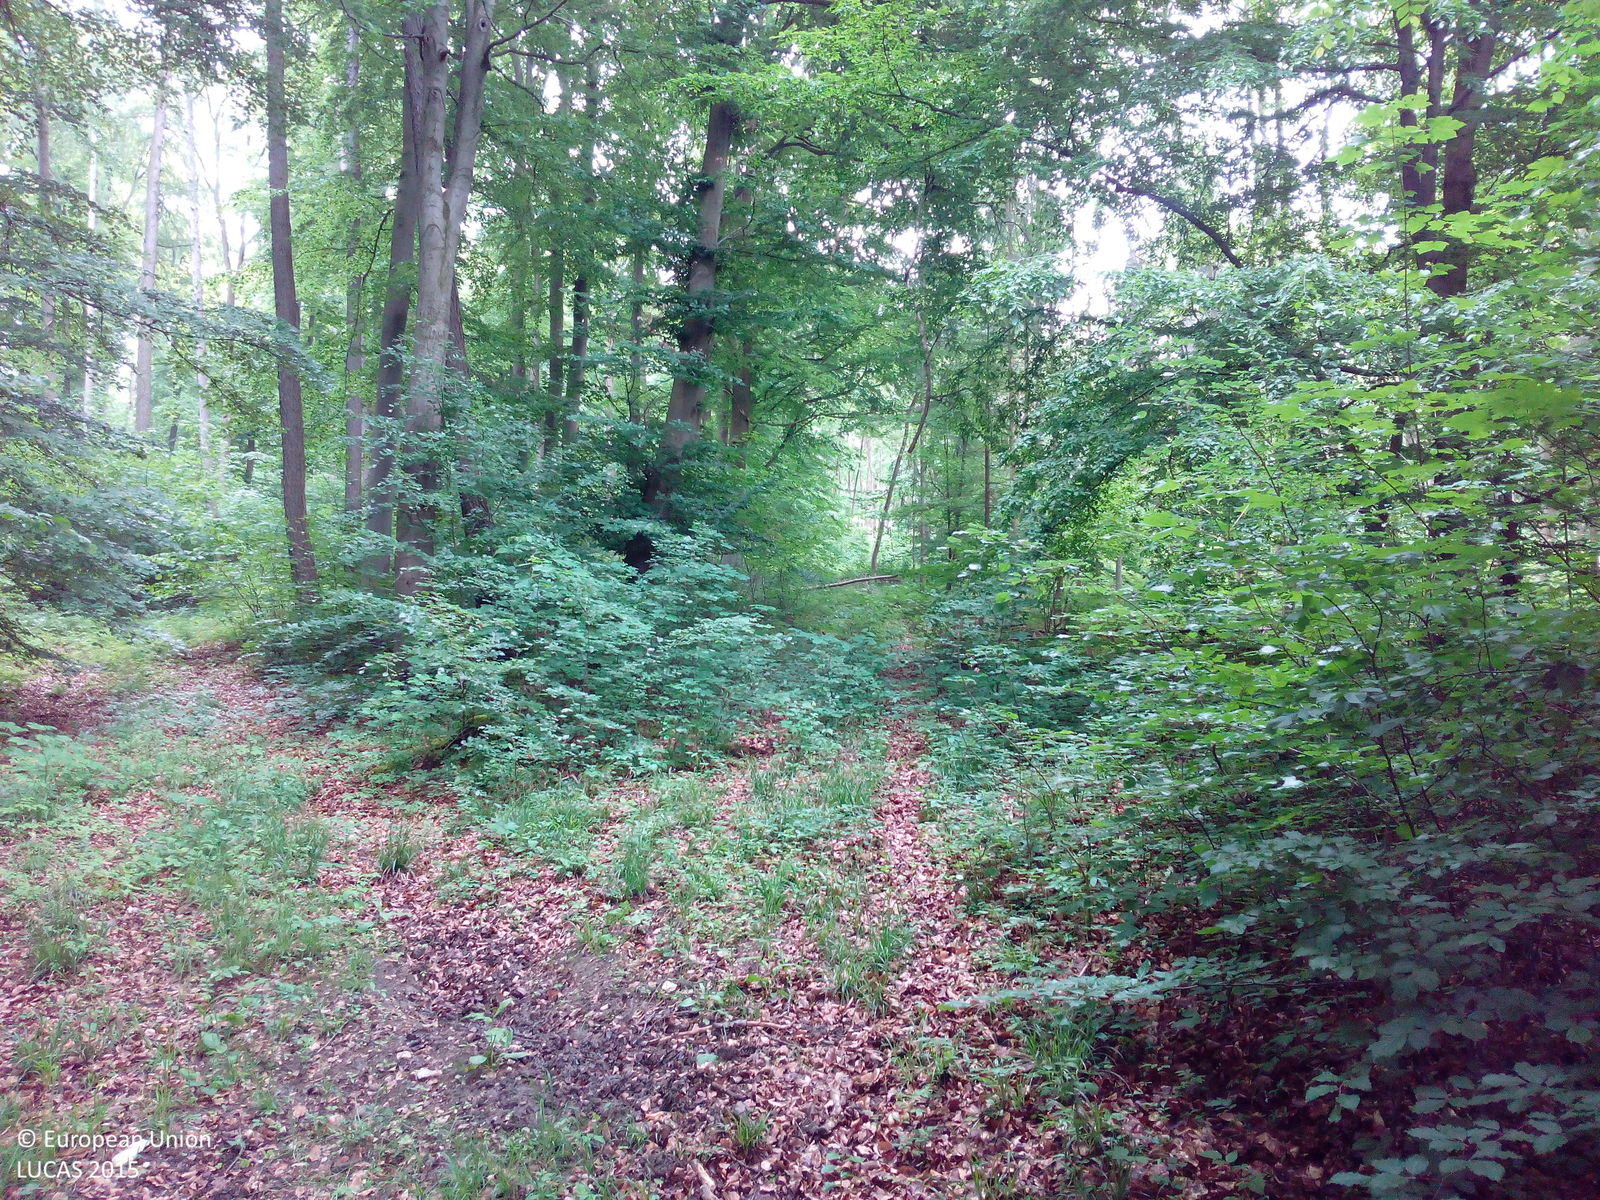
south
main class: Woodland
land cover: Broadleaved woodland
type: beech forest
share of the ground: > 75 %
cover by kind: broadleaved forest trees 100 %
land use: Forestry
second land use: Amenities, museums, leisure
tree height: > 5 m
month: May
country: DE
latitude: 52.0177
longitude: 10.2768
